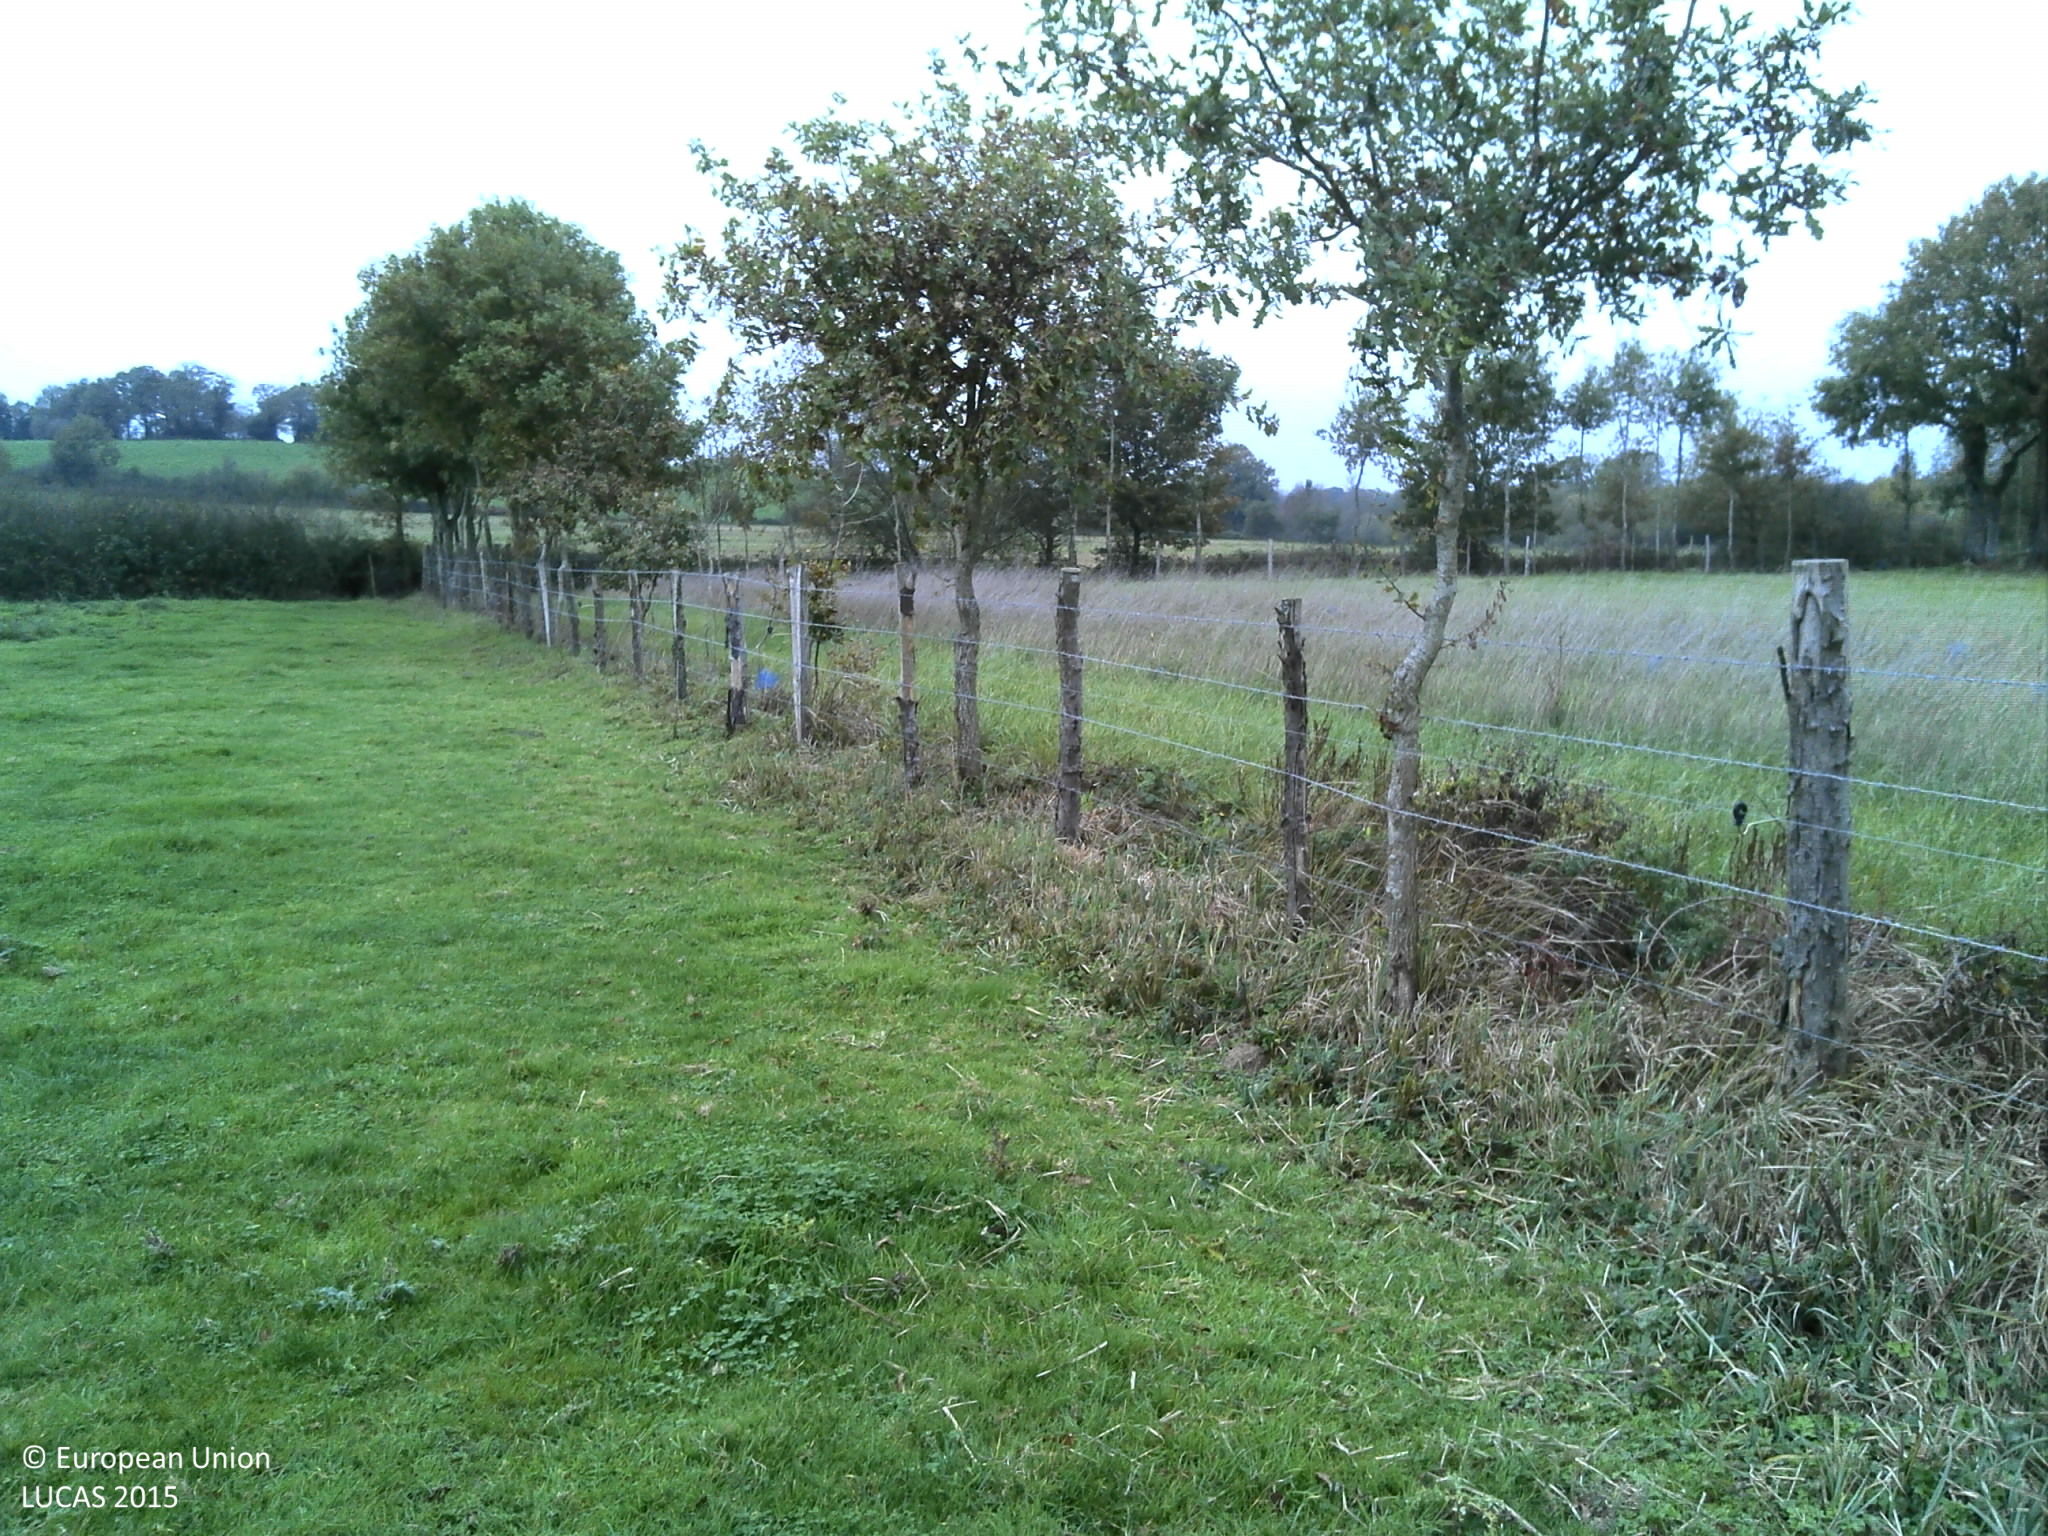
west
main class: Grassland
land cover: Grassland without tree/shrub cover
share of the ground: > 75 %
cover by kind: herbaceous plants 100 %
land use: Agriculture (excluding fallow land and kitchen gardens)
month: November
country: FR
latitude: 47.6362
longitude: -1.3412
